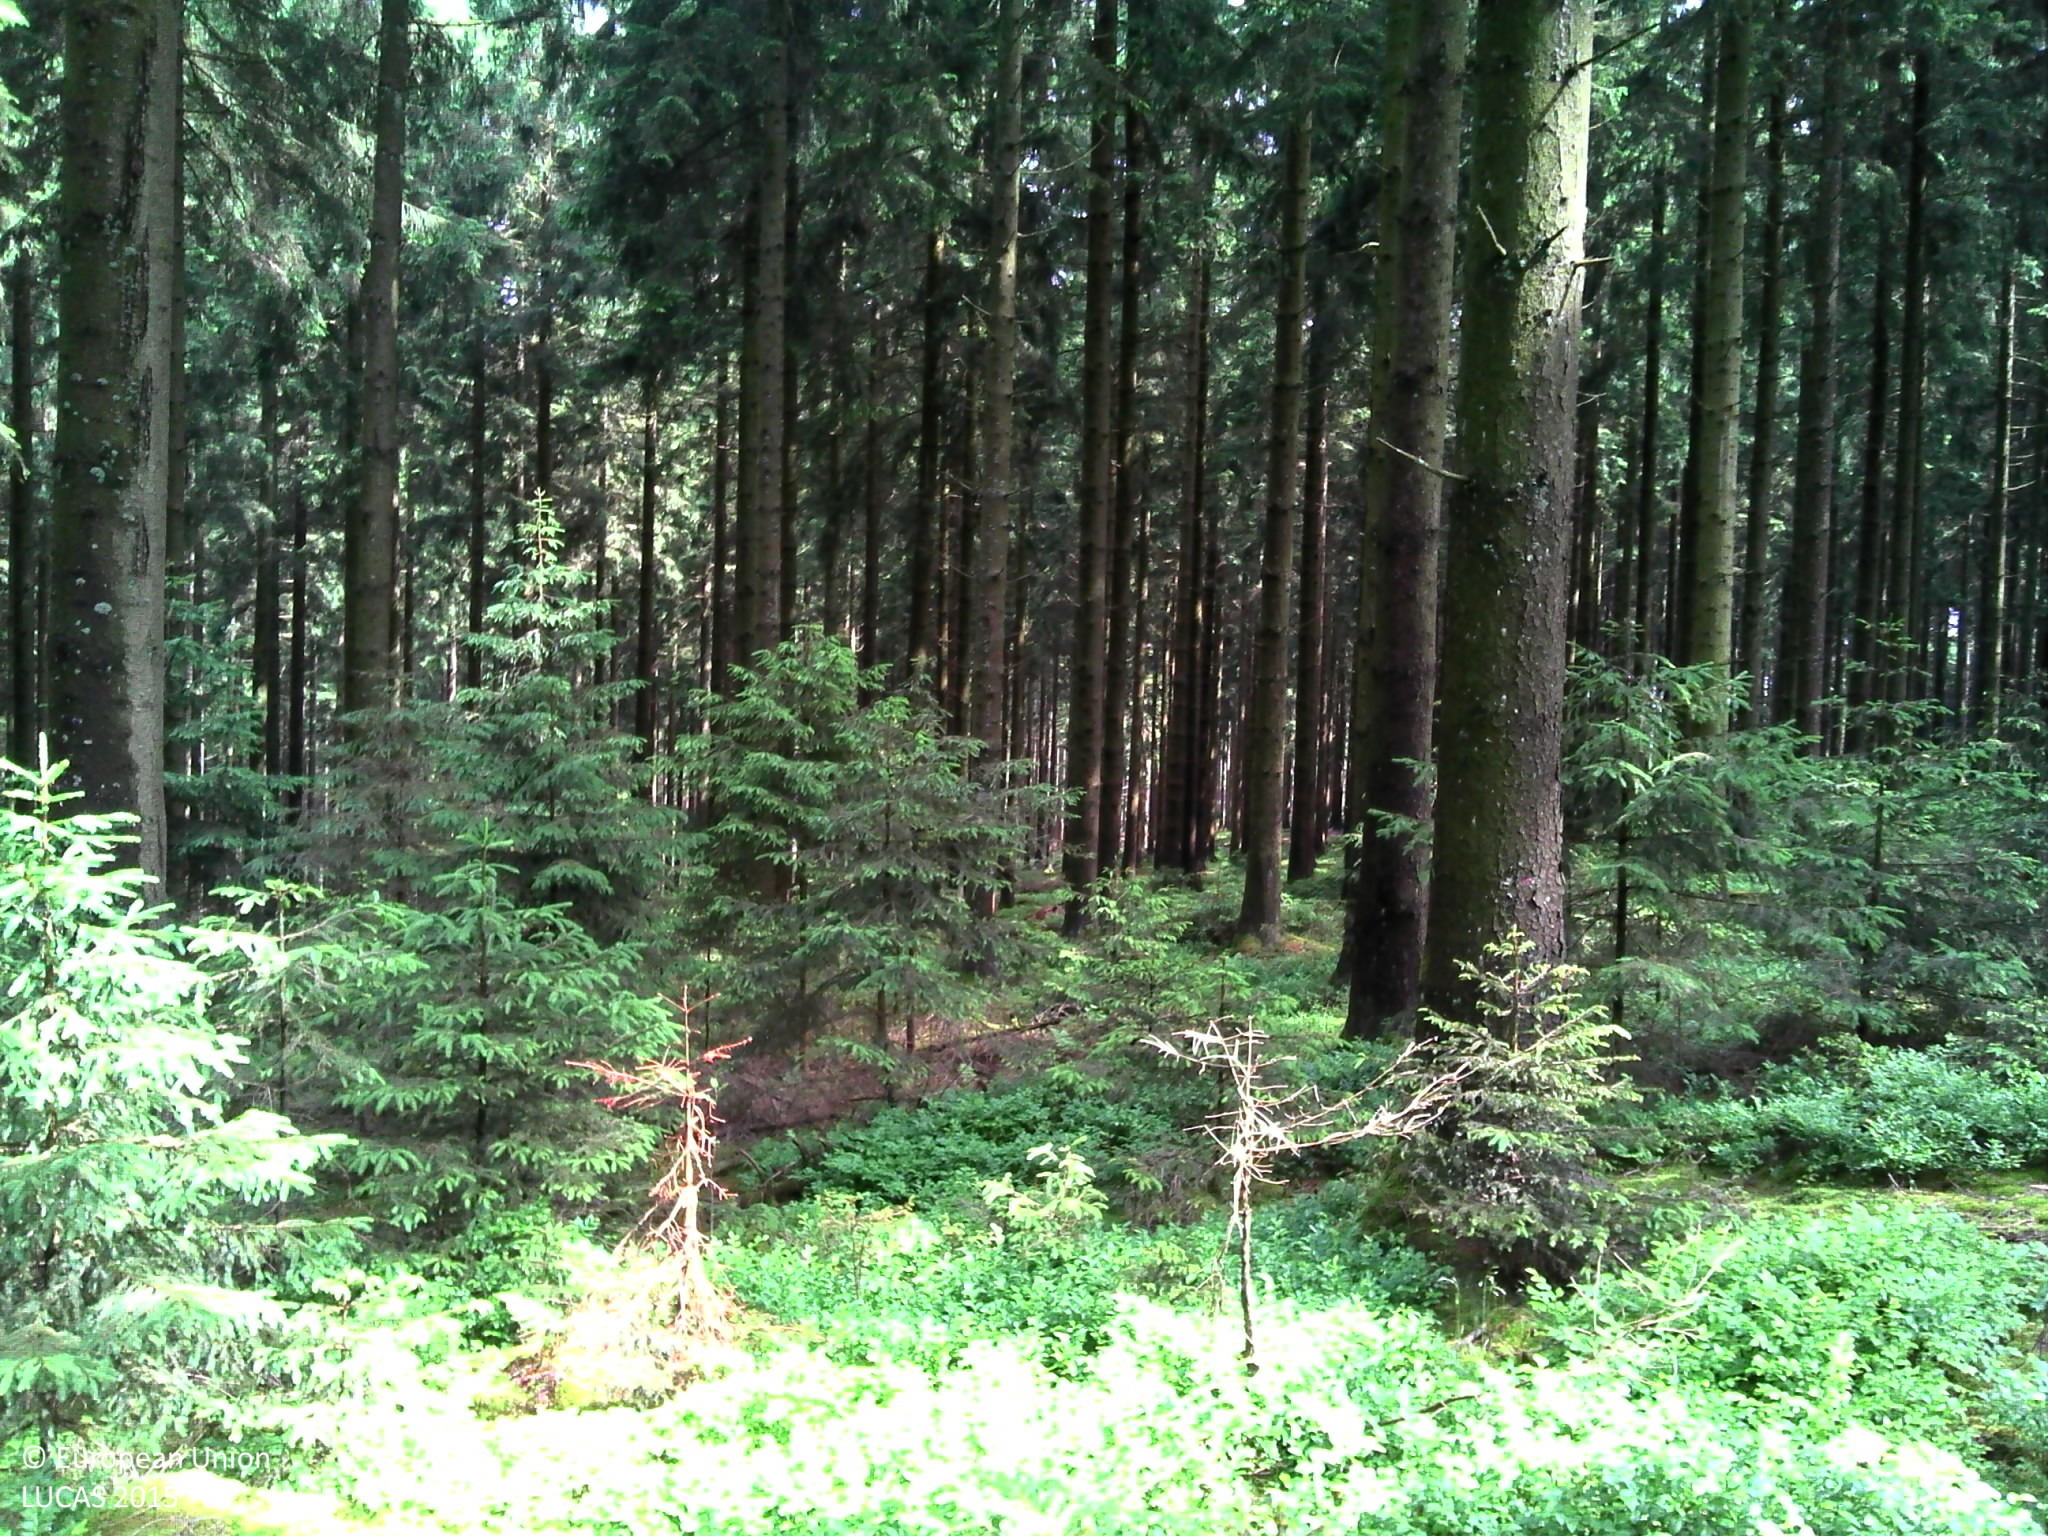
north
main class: Woodland
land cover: Spruce dominated coniferous woodland
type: alpine coniferous forest
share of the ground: > 75 %
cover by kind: coniferous forest trees 80 %, shrubs 10 %, herbaceous plants 5 %, lichens and mosses 5 %
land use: Forestry
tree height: > 5 m
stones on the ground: 10 - 25 %
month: June
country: BE
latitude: 50.3177
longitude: 5.6589
